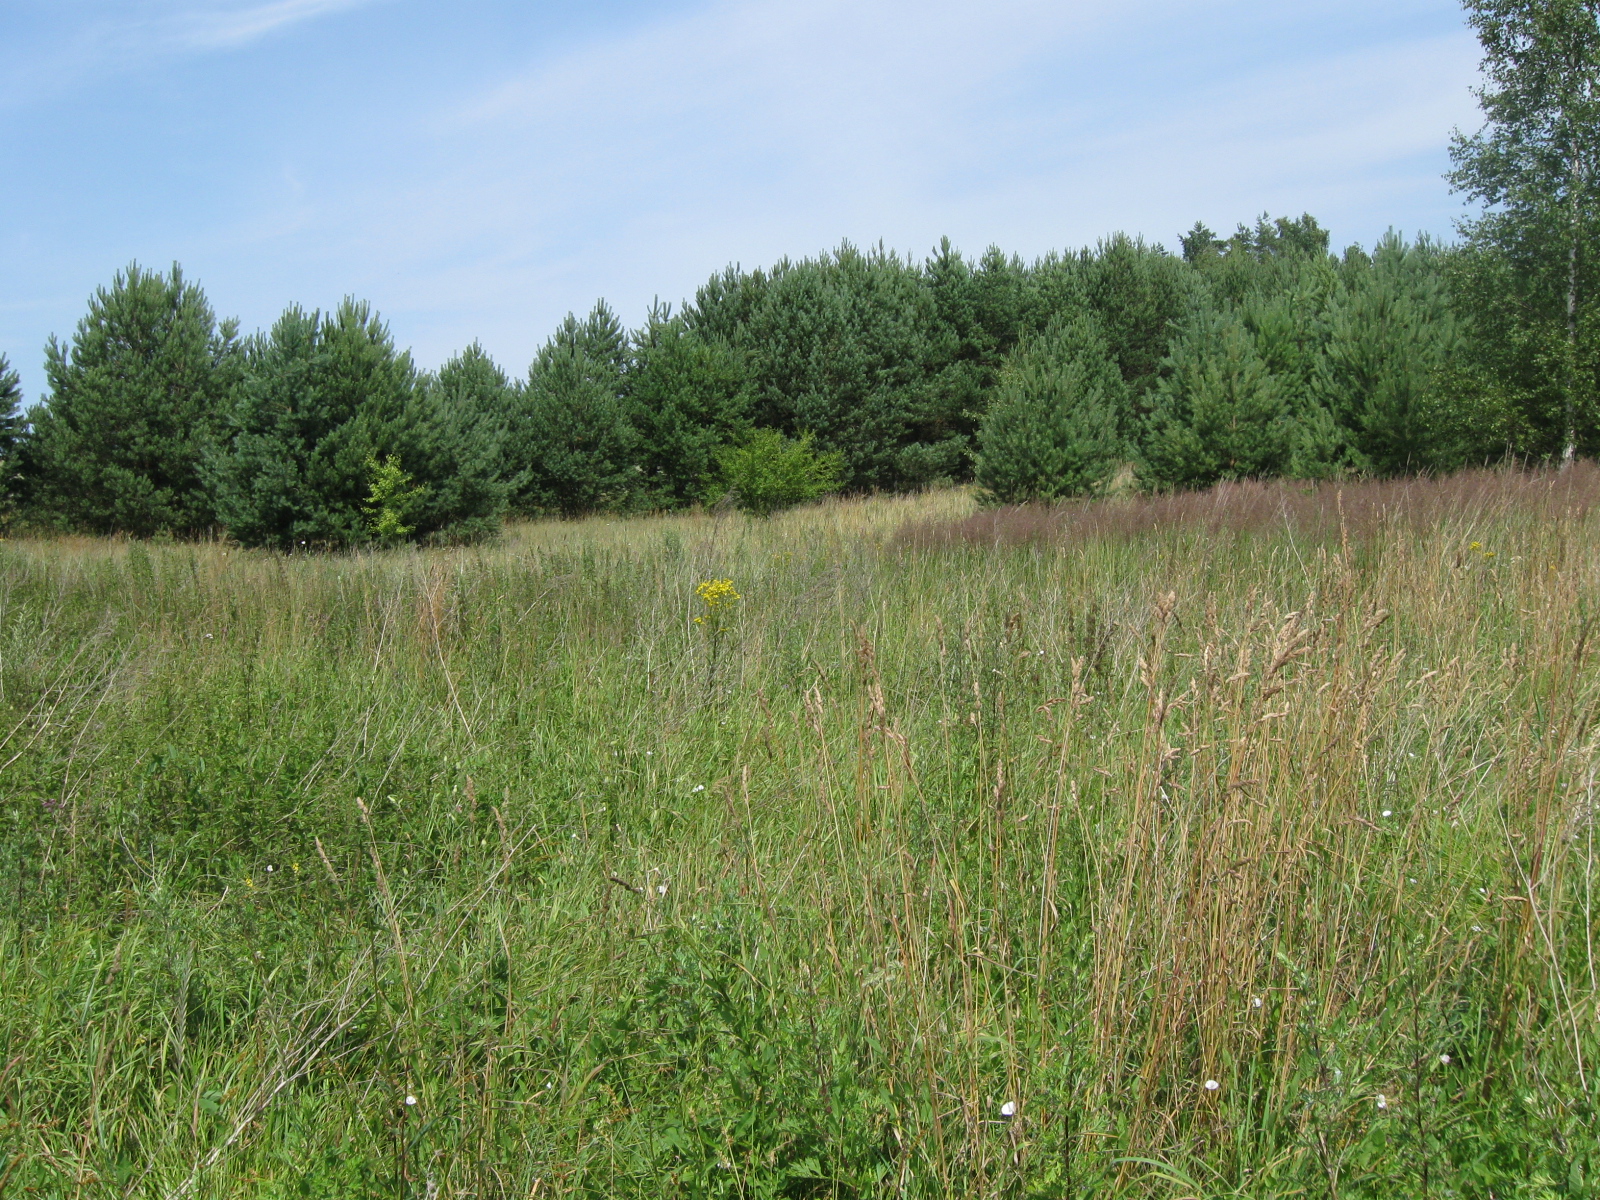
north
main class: Grassland
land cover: Spontaneously vegetated surfaces
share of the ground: > 75 %
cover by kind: herbaceous plants 100 %
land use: Fallow land
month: July
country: LT
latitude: 54.7079
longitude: 23.9502
